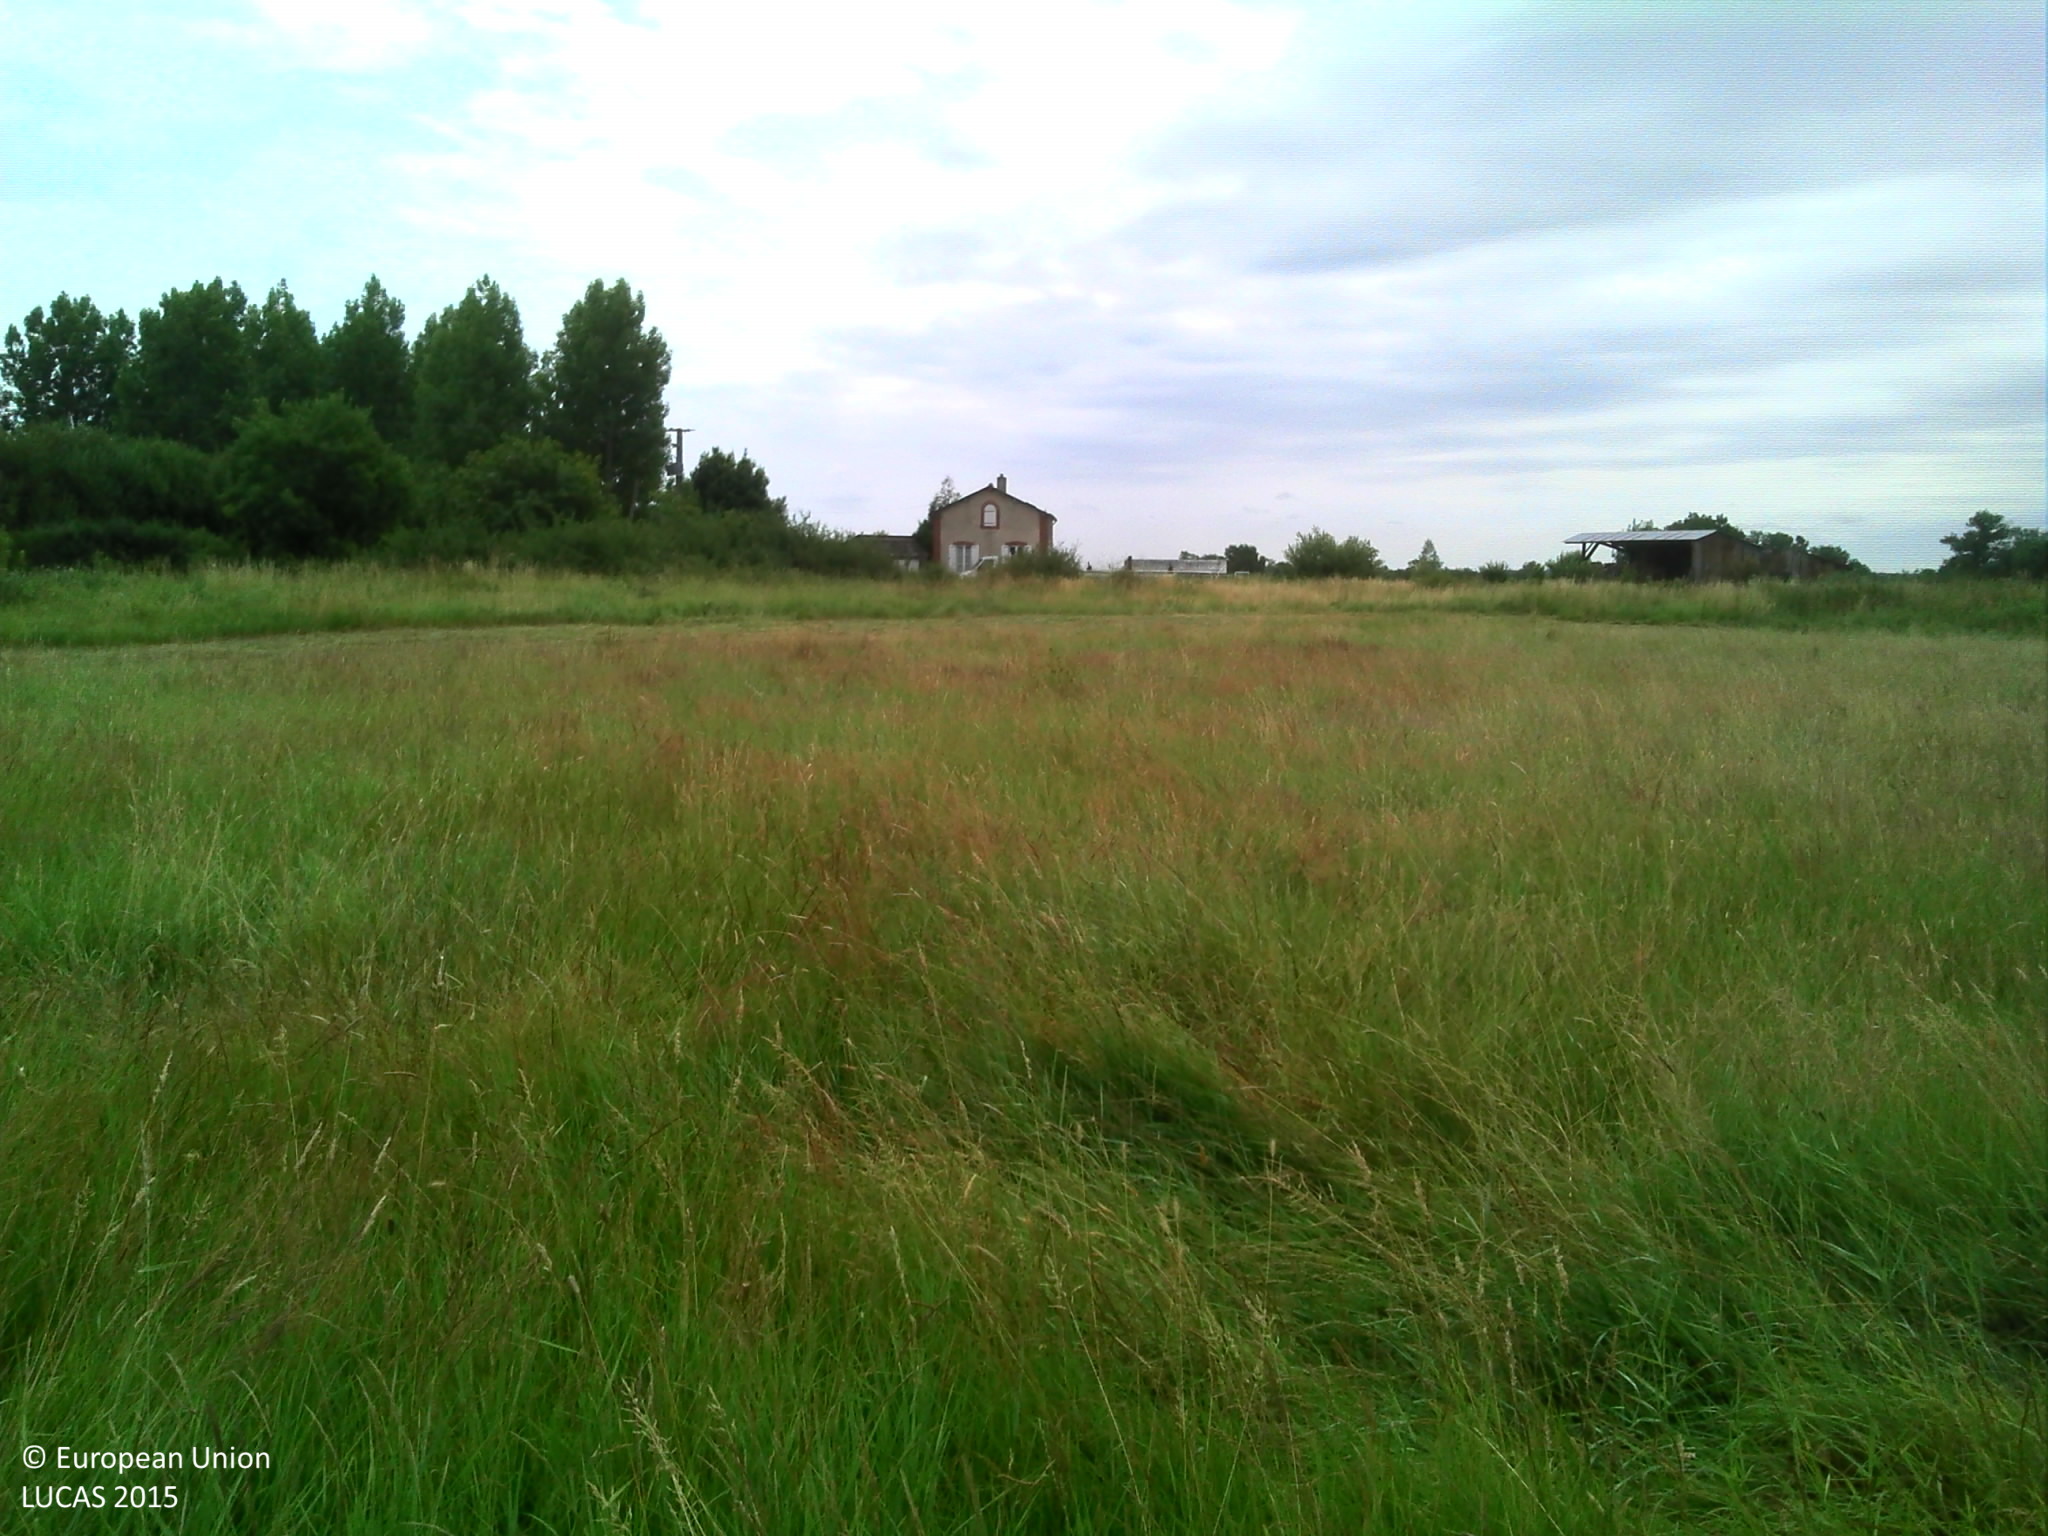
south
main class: Grassland
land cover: Grassland without tree/shrub cover
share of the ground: > 75 %
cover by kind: herbaceous plants 100 %
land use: Agriculture (excluding fallow land and kitchen gardens)
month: July
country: FR
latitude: 47.2343
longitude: -1.8683
